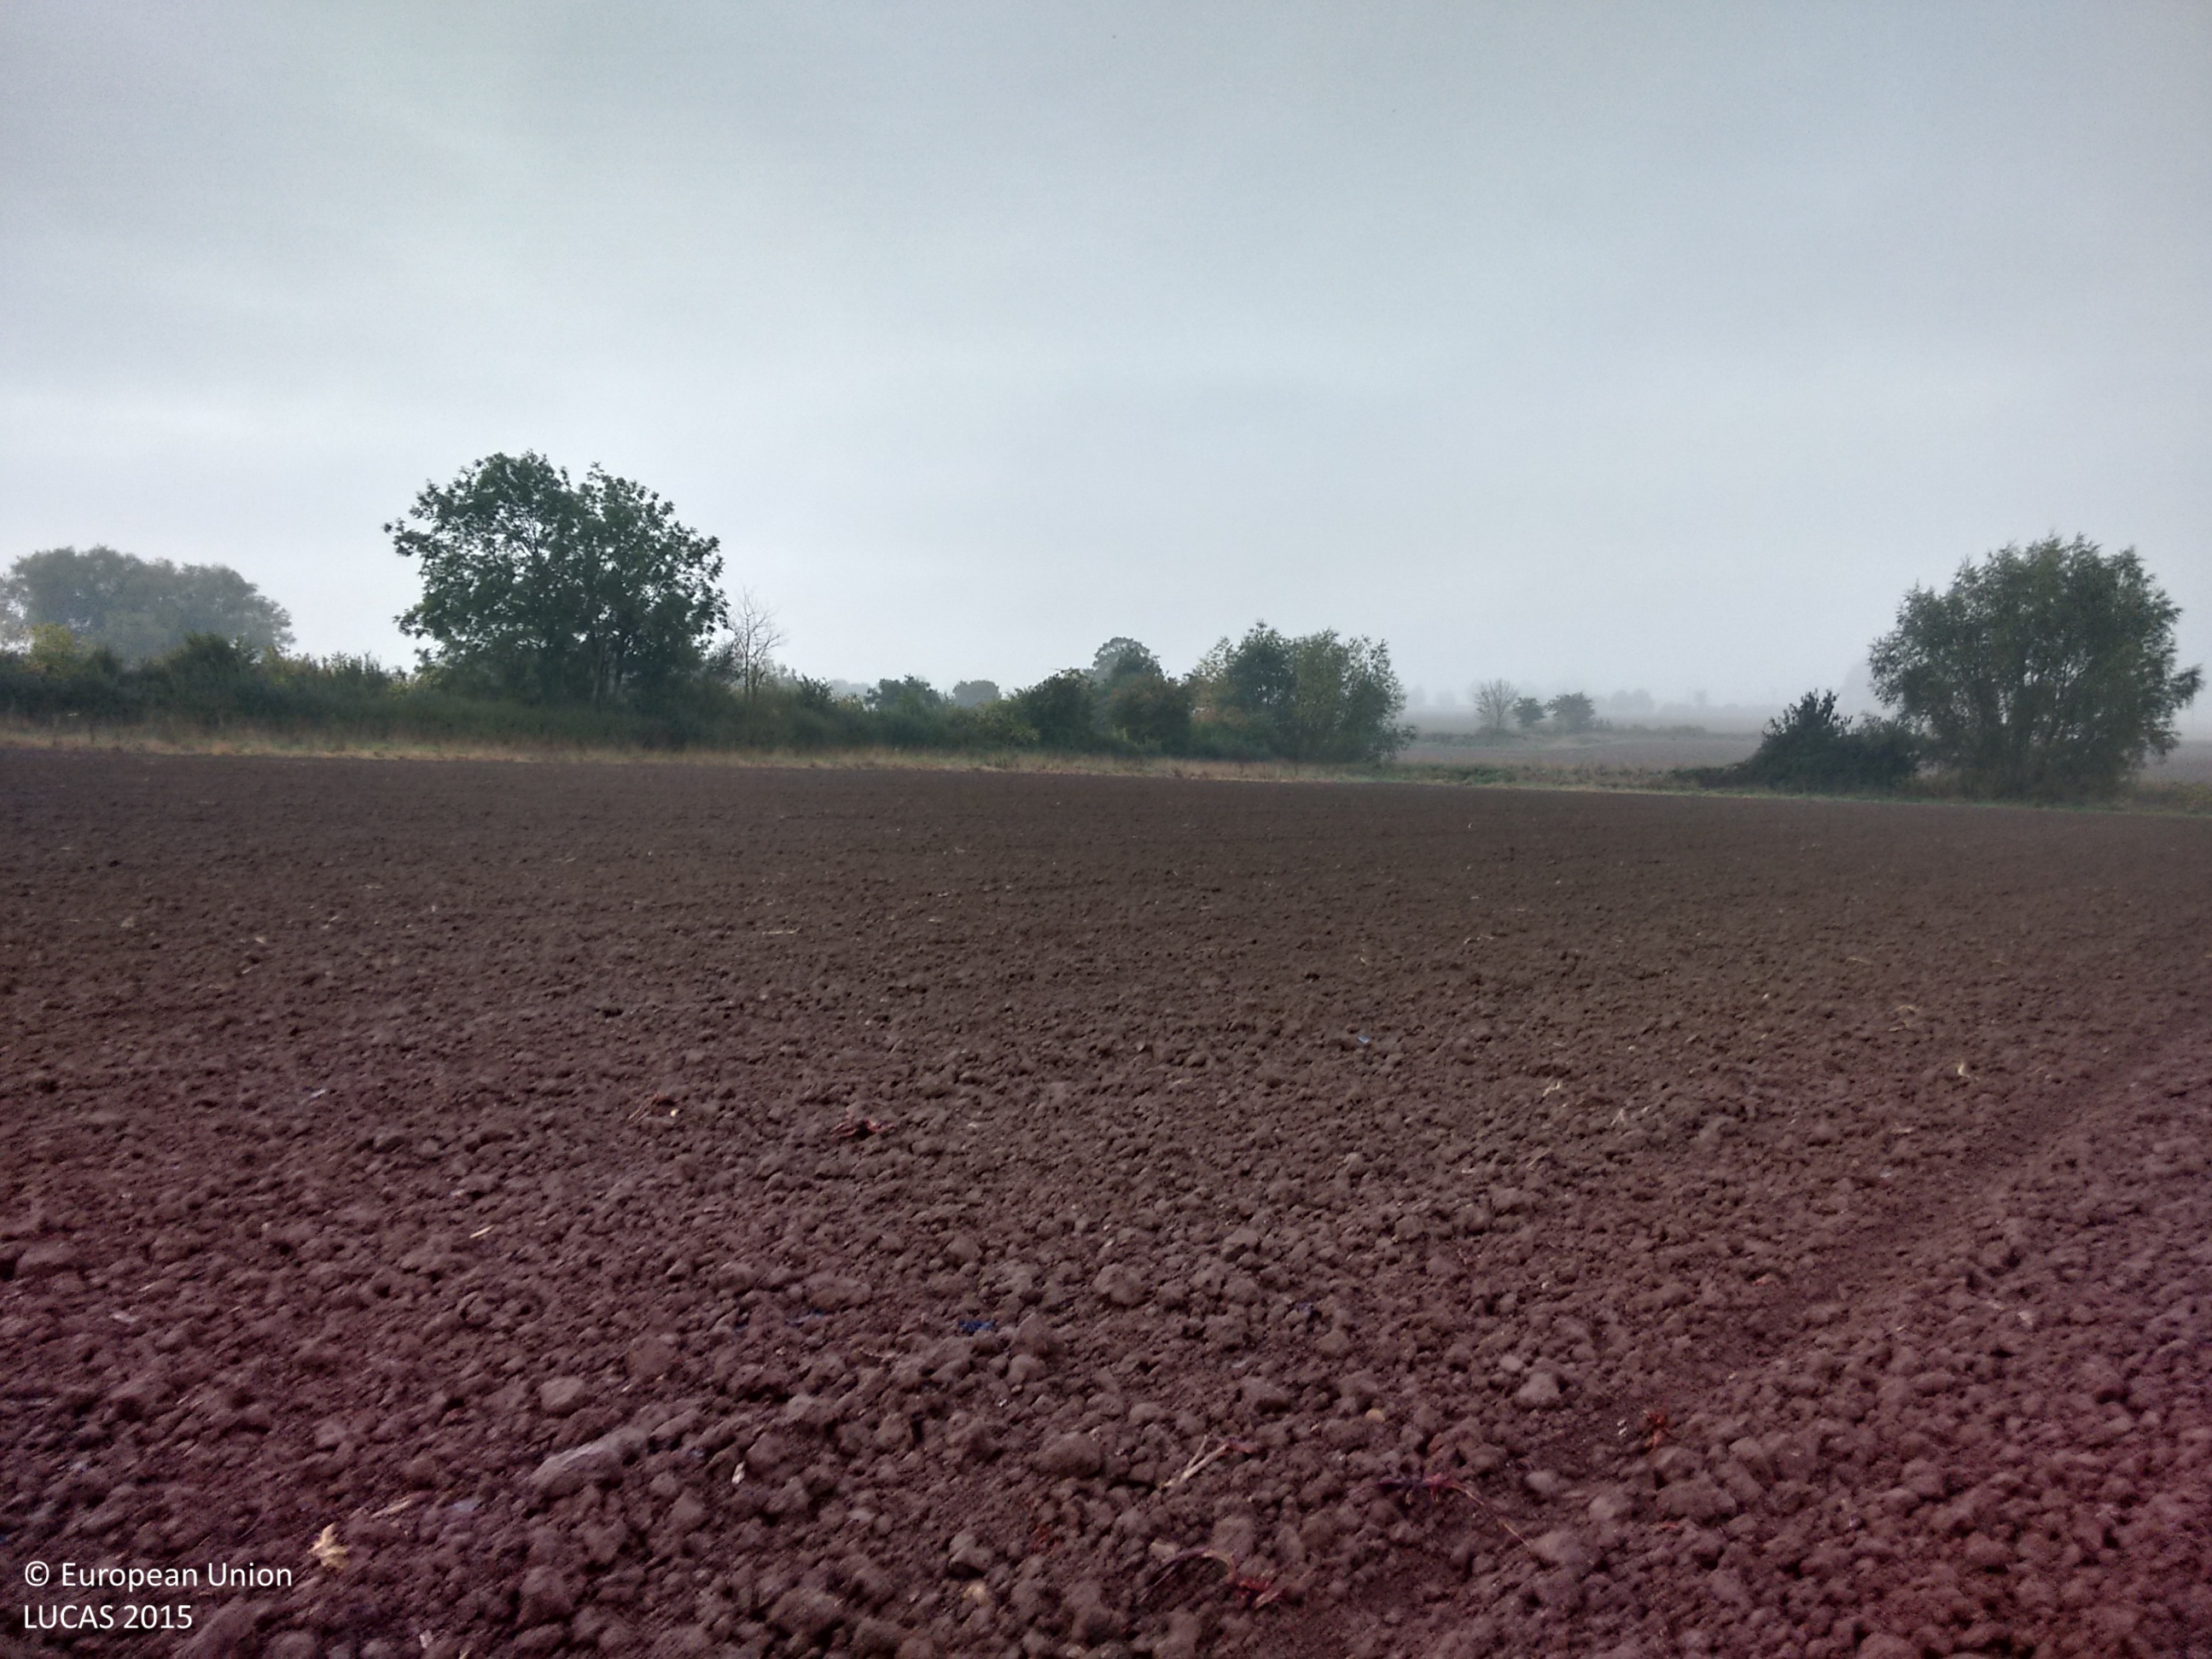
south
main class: Cropland
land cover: Common wheat
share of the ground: > 75 %
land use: Agriculture (excluding fallow land and kitchen gardens)
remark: Harvested field
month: October
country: GB
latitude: 51.7289
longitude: -2.3562
